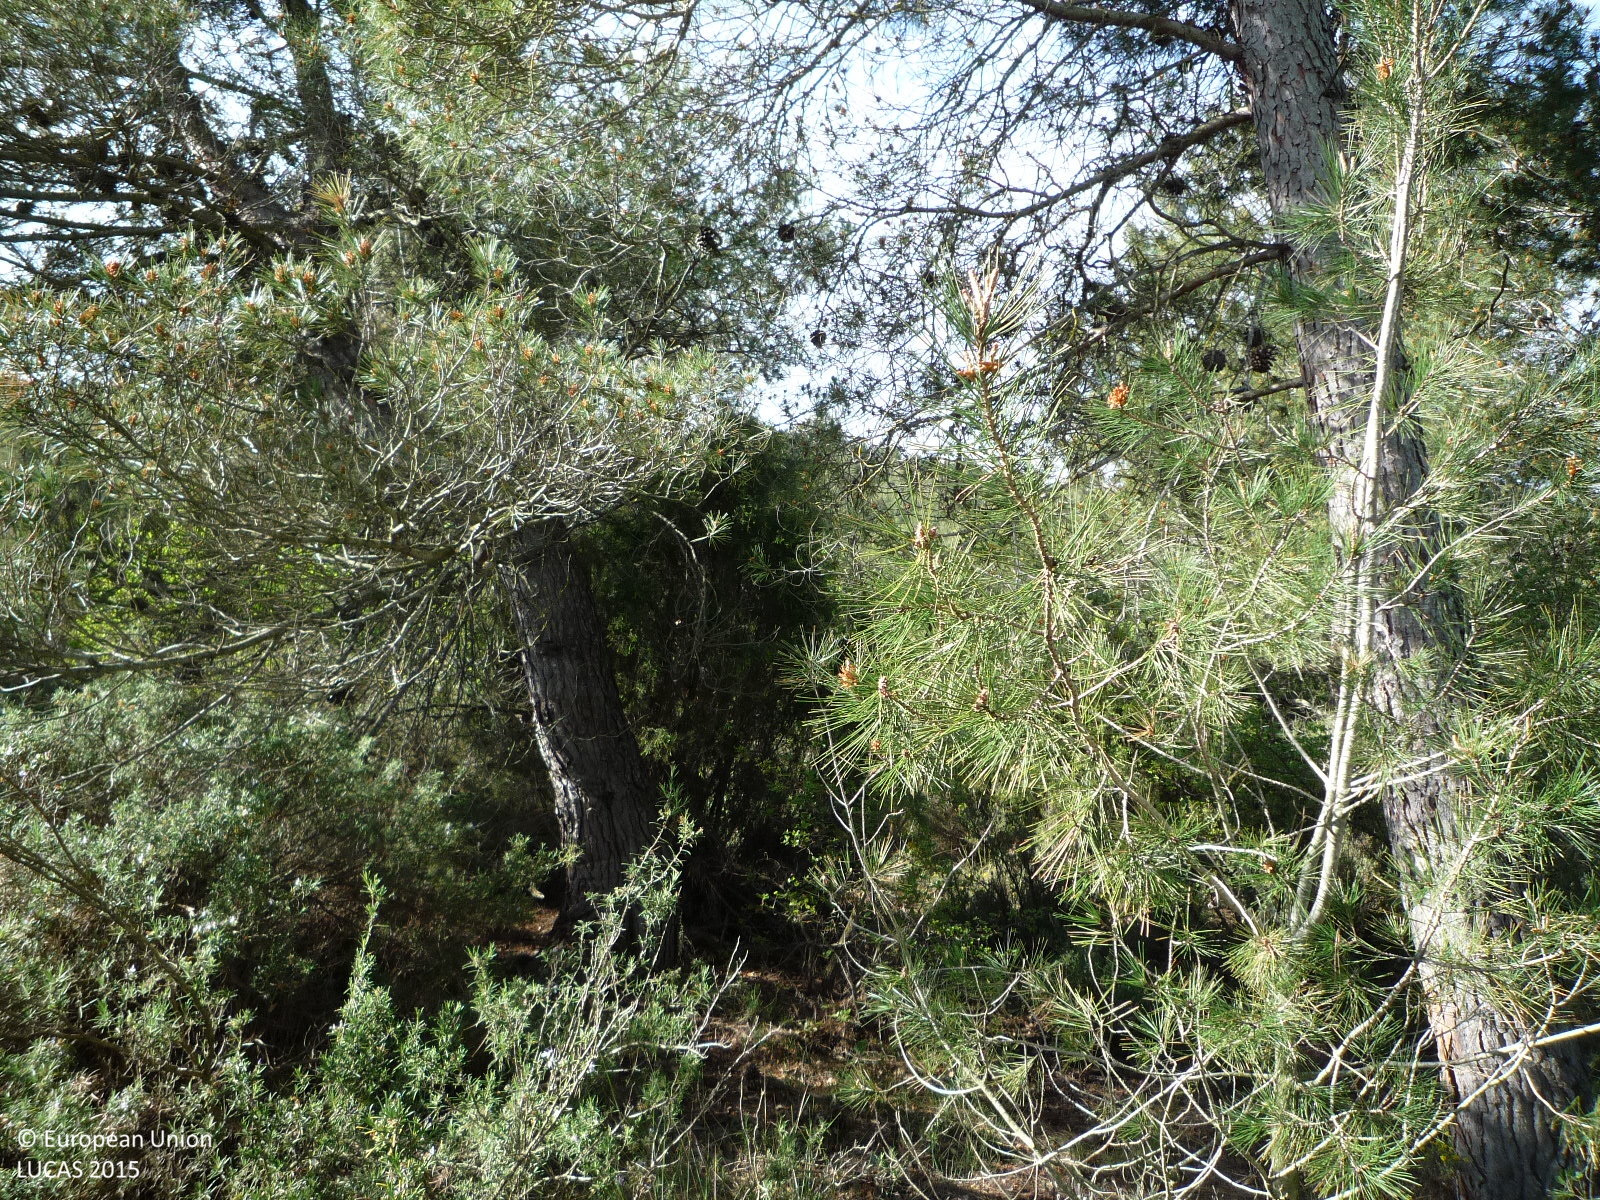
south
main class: Woodland
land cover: Pine dominated mixed woodland
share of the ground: > 75 %
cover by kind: coniferous forest trees 75 %, broadleaved forest trees 25 %
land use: Semi-natural and natural areas not in use
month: April
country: ES
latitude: 41.7147
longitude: 1.7096
